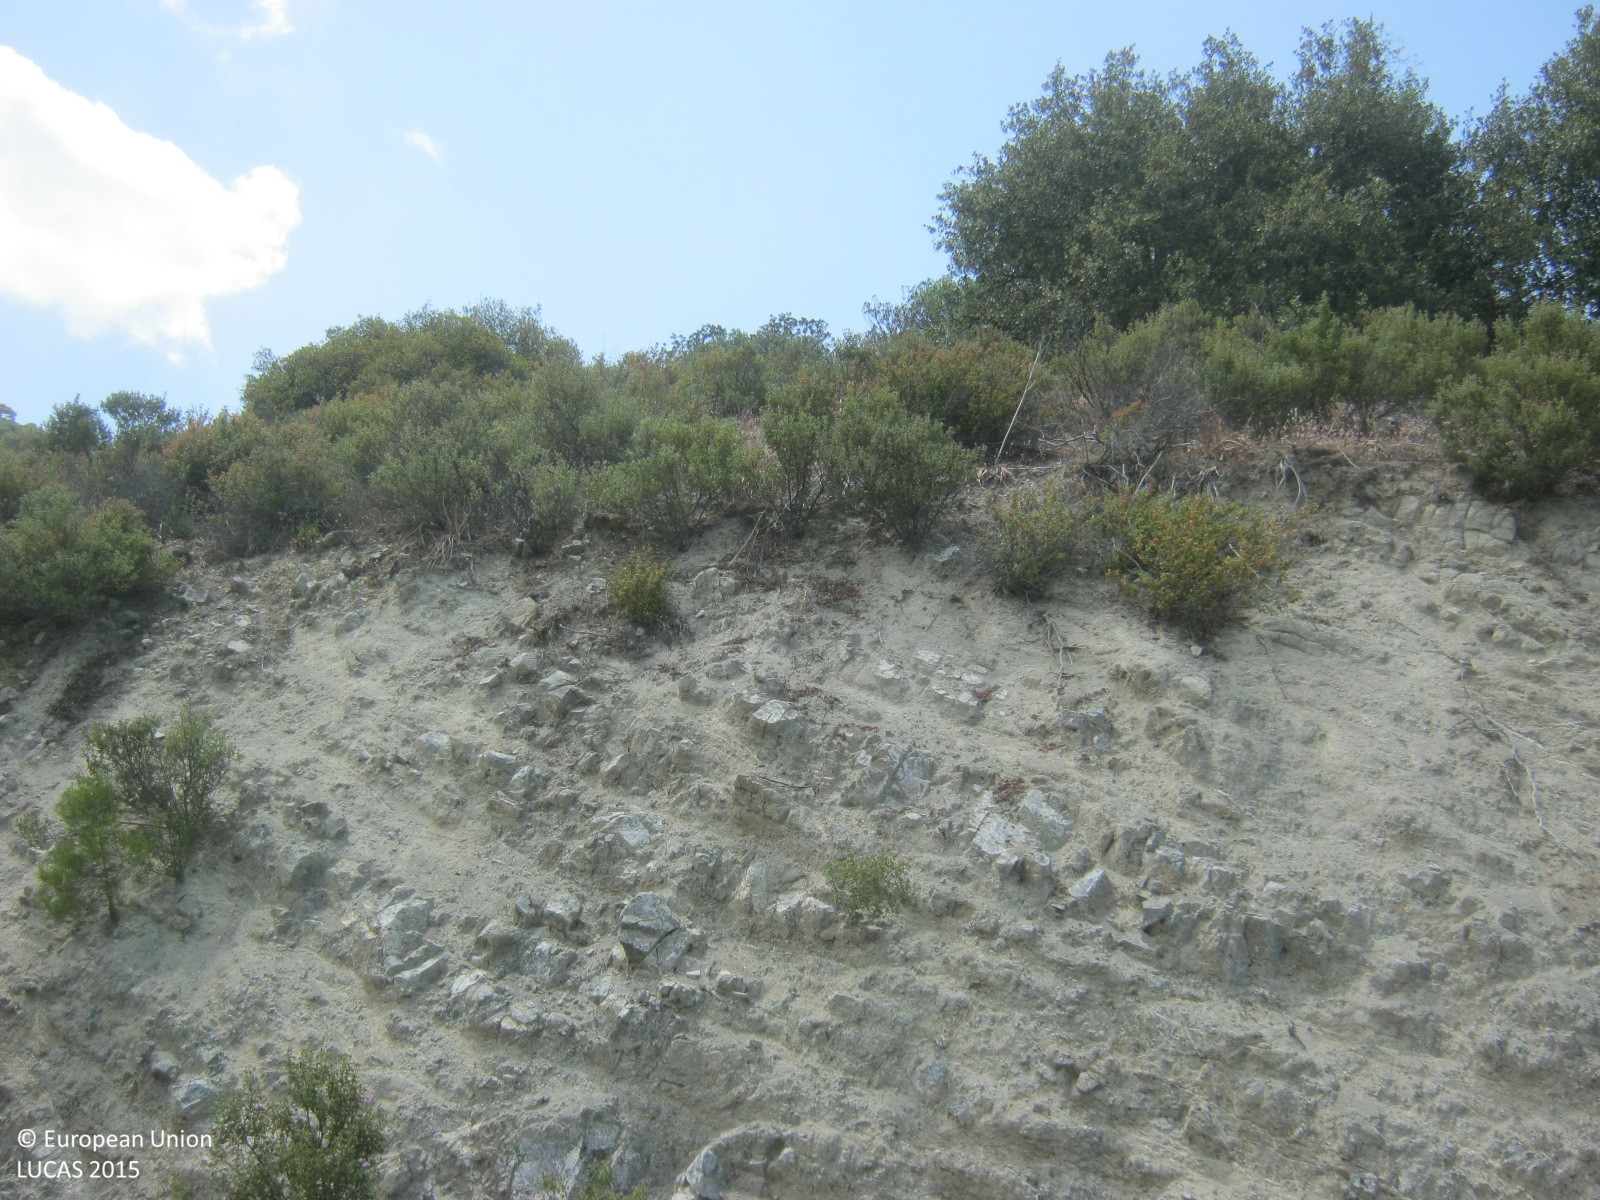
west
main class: Woodland
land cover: Pine dominated coniferous woodland
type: coniferous forest of the mediterranean region
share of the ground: > 75 %
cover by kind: coniferous forest trees 80 %, shrubs 10 %, broadleaved forest trees 5 %, unconsolidated bare surface 5 %
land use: Forestry
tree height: > 5 m
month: June
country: CY
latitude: 34.9985
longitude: 32.8594
